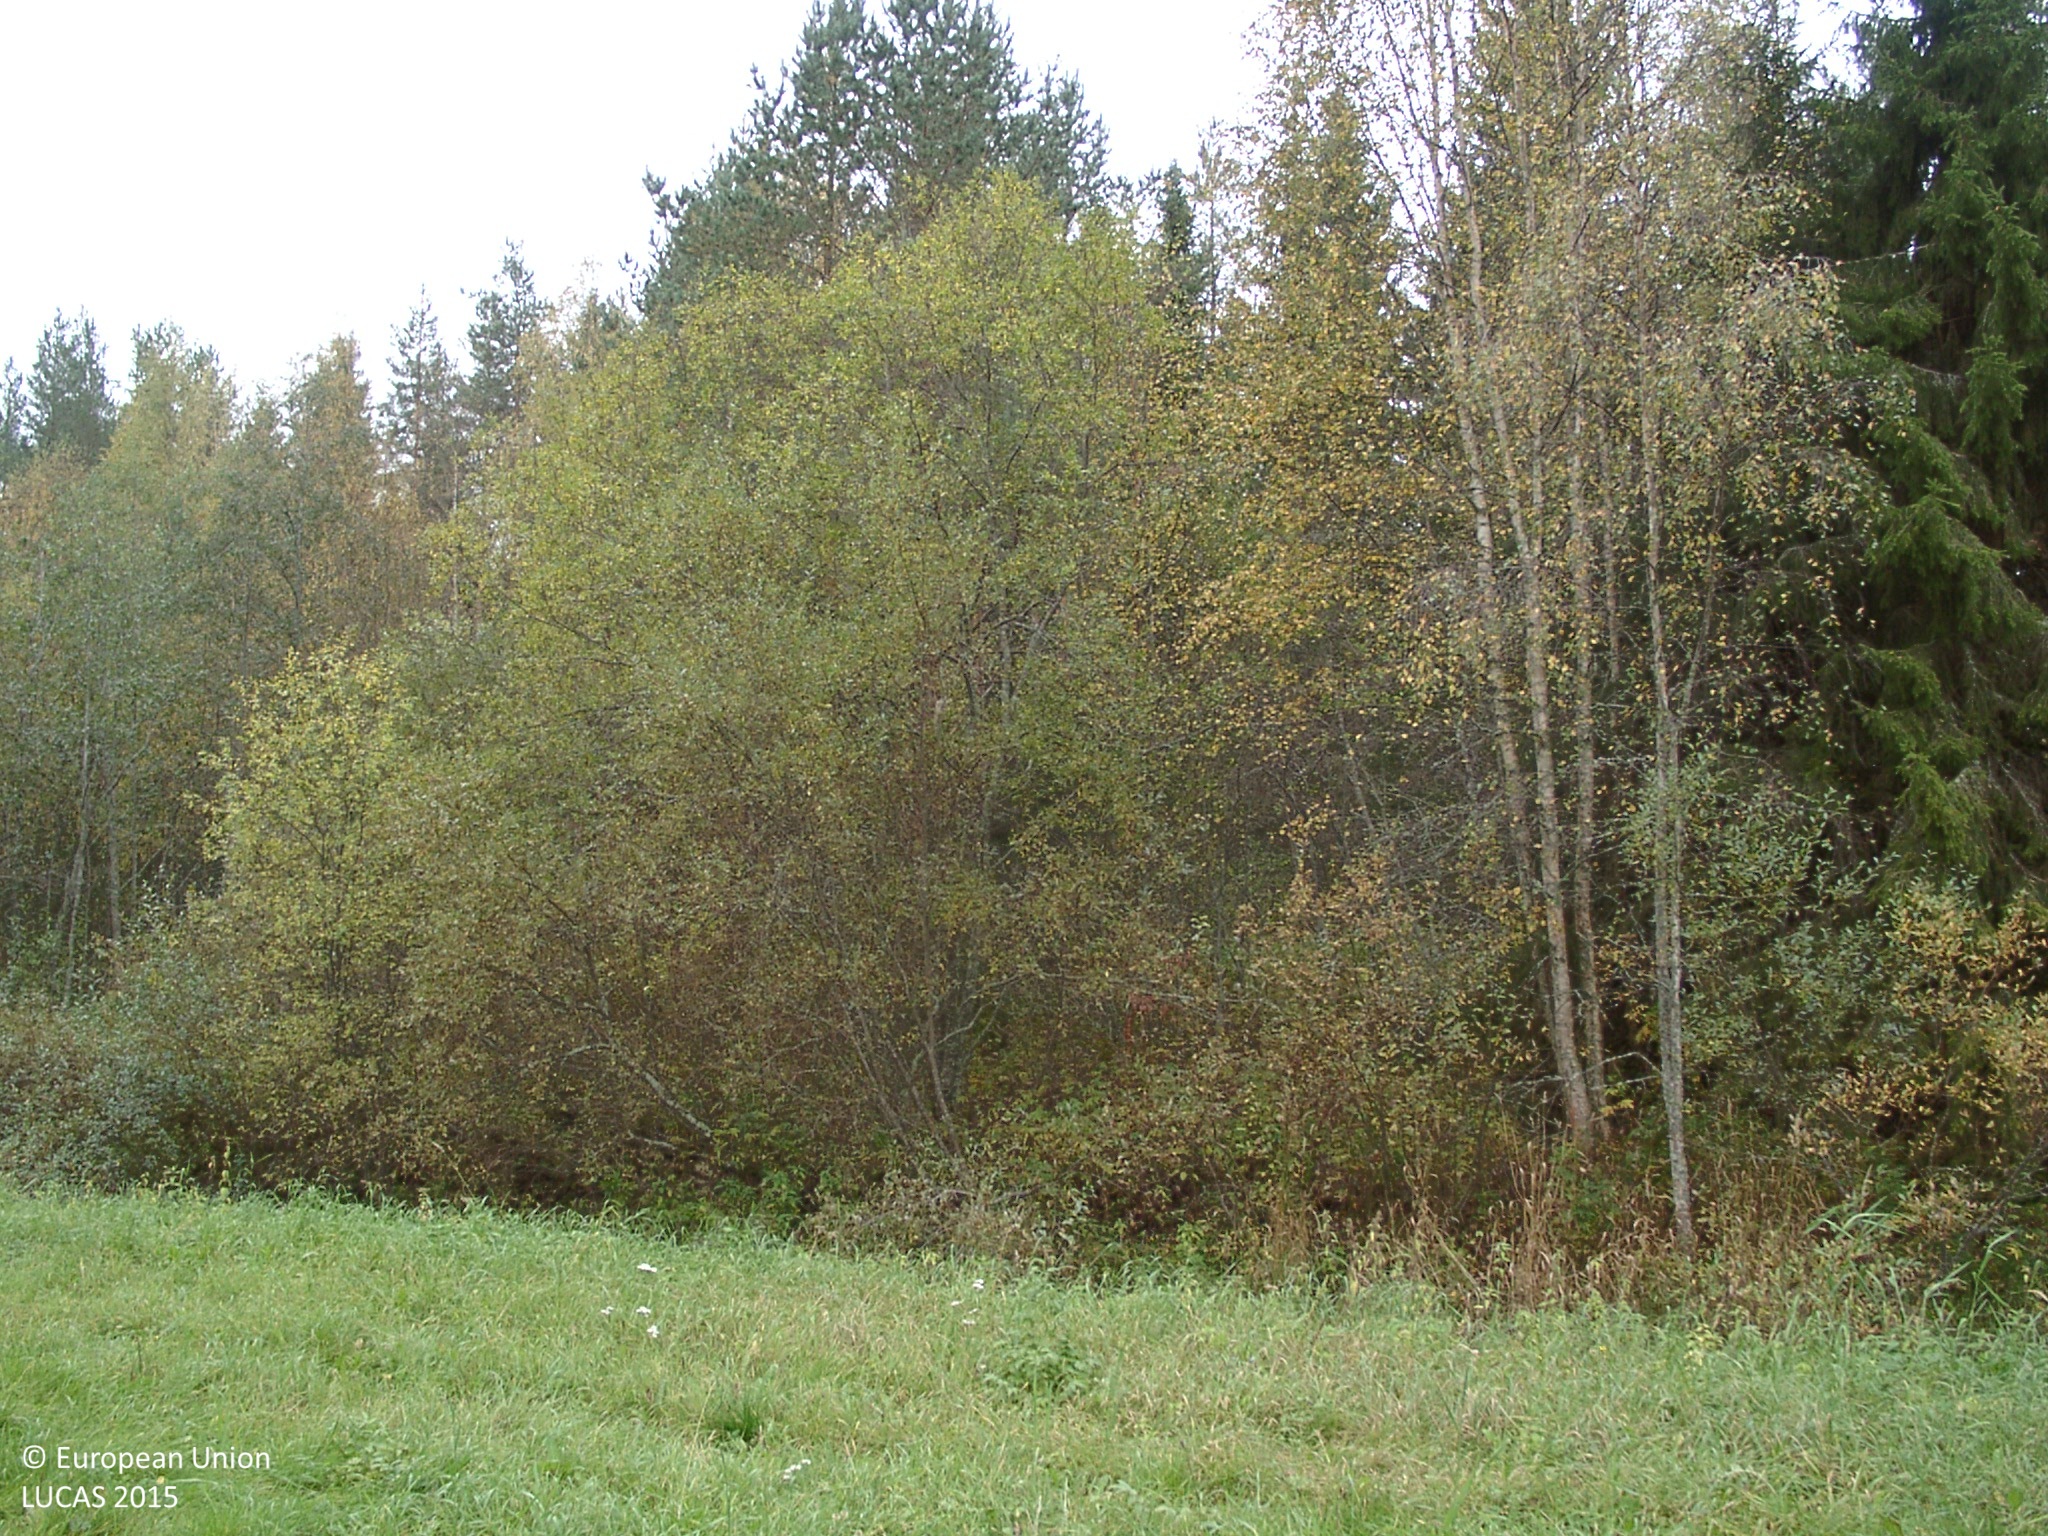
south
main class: Grassland
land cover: Grassland without tree/shrub cover
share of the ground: > 75 %
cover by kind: herbaceous plants 100 %
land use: Agriculture (excluding fallow land and kitchen gardens)
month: September
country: FI
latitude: 62.6565
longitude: 25.2678
